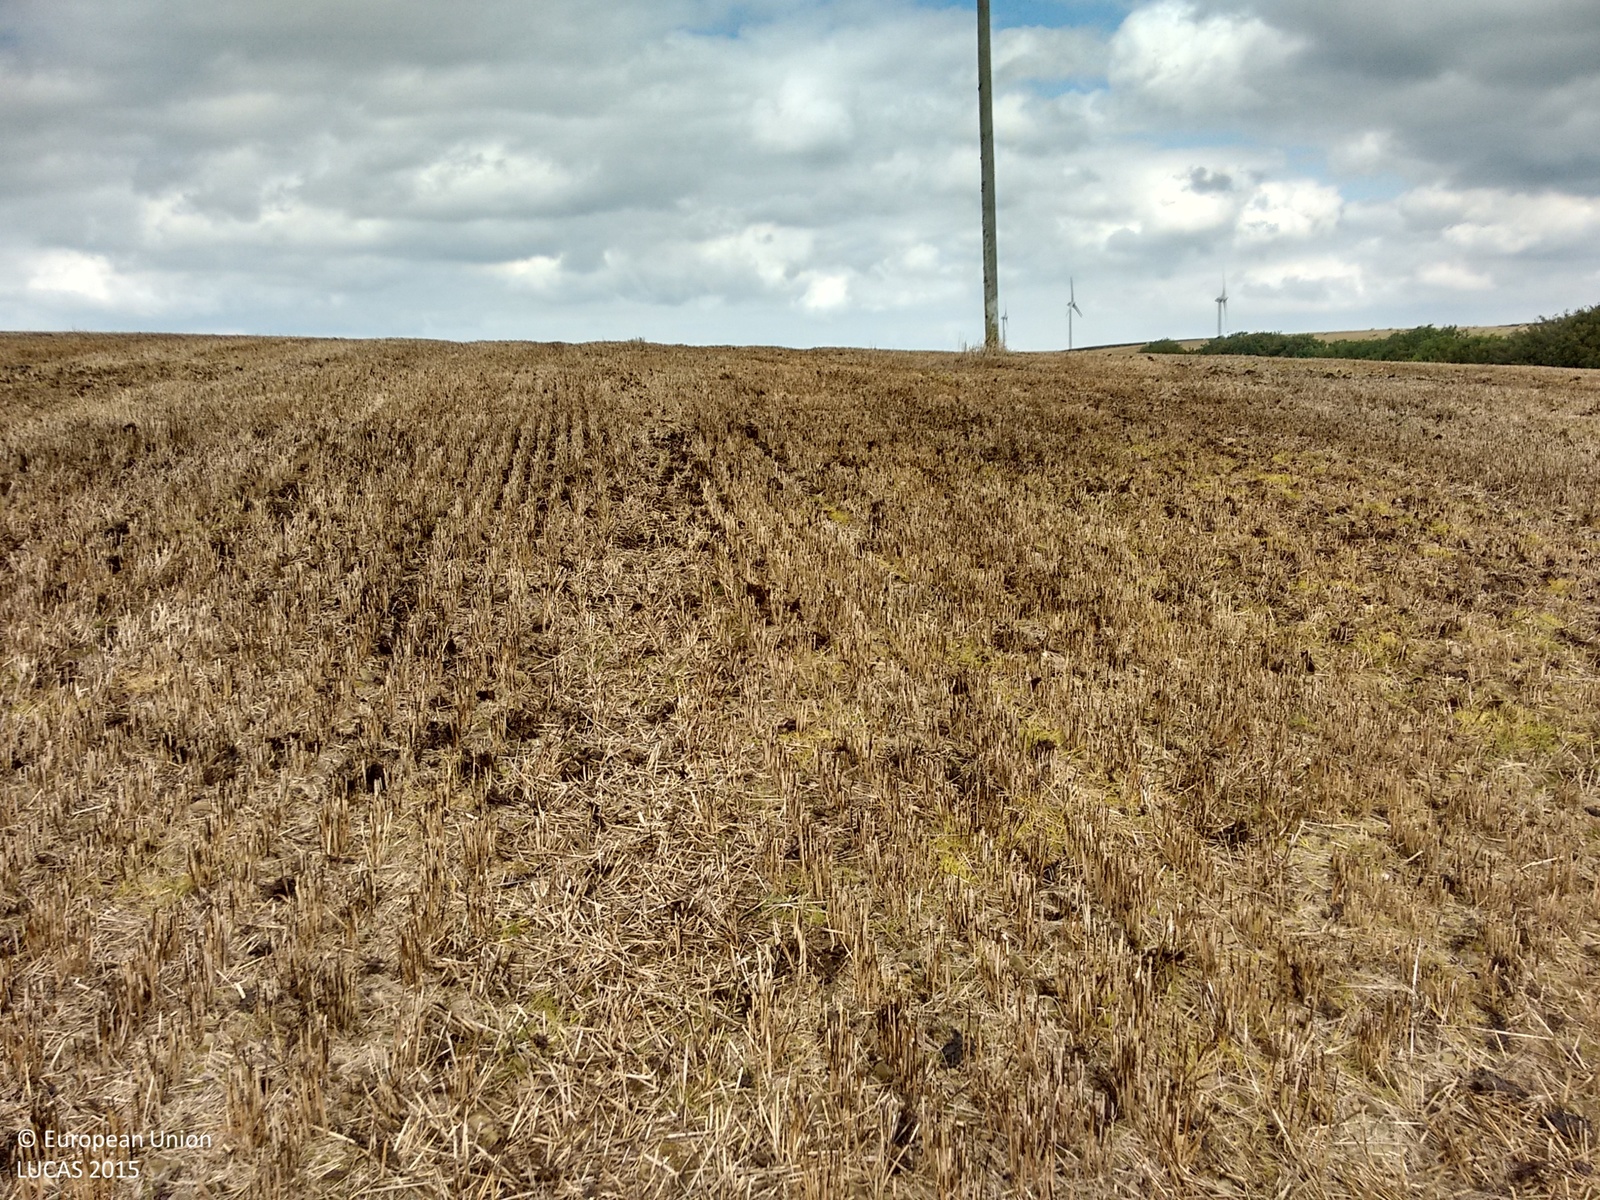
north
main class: Cropland
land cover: Barley
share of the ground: 50 - 75 %
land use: Agriculture (excluding fallow land and kitchen gardens)
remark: Harvested field
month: September
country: GB
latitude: 50.9054
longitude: -4.2781
